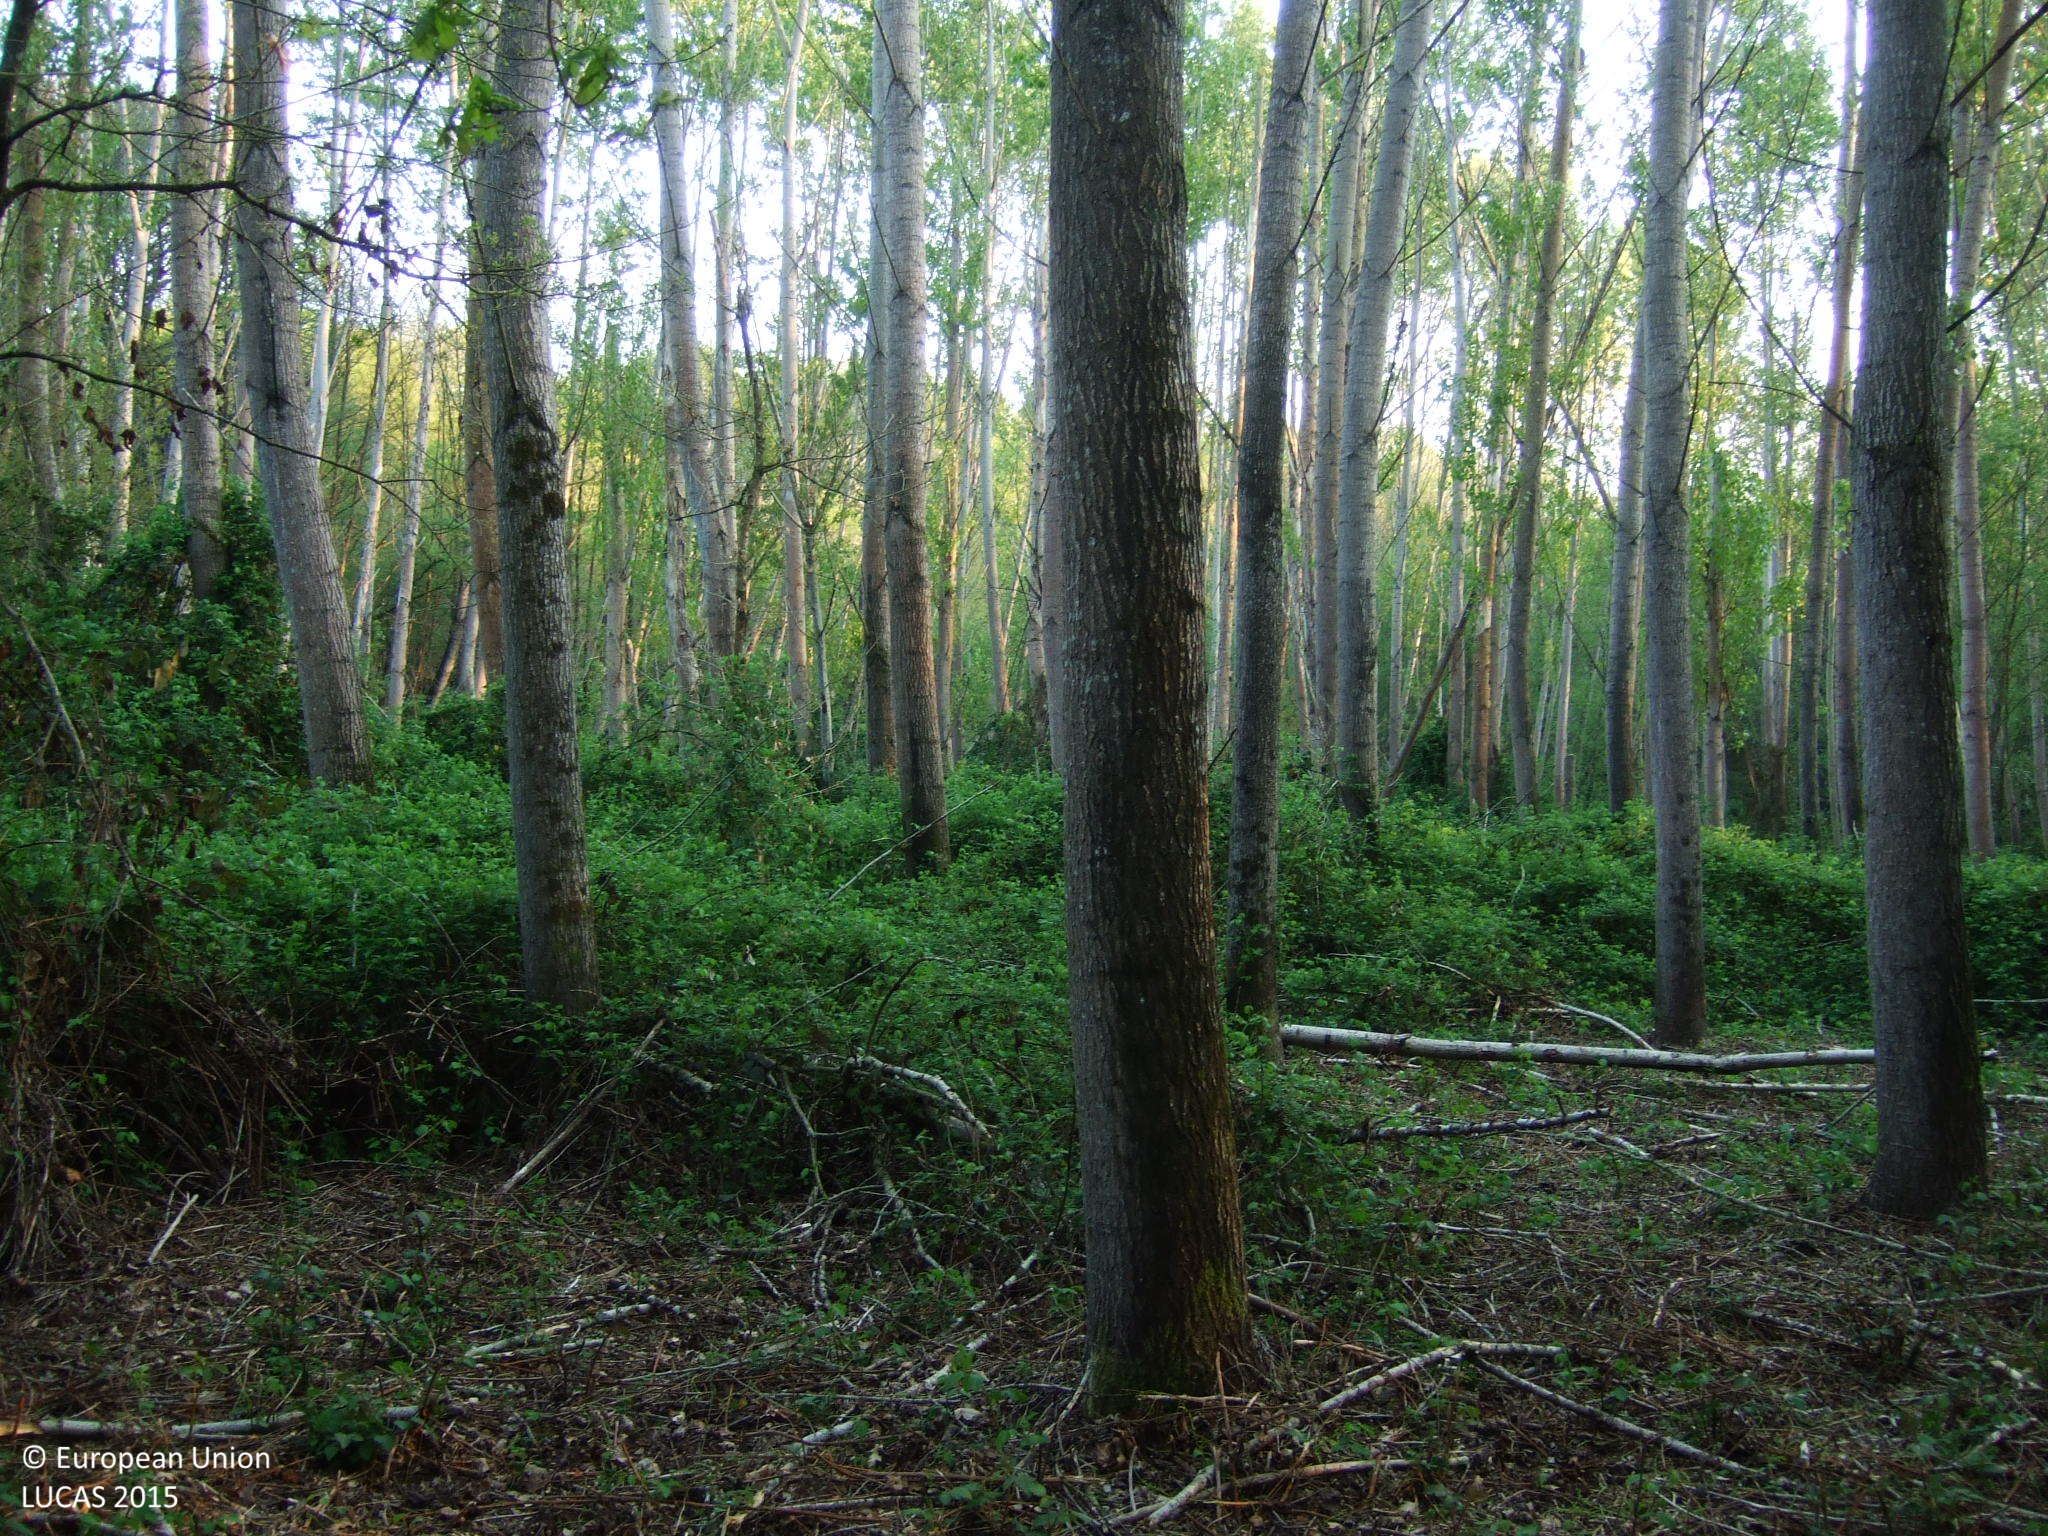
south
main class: Woodland
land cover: Broadleaved woodland
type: acidophilous oak and oak-birch forest
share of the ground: > 75 %
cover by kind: broadleaved forest trees 90 %, shrubs 10 %
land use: Forestry
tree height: > 5 m
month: April
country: ES
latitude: 43.0181
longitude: -7.5879
